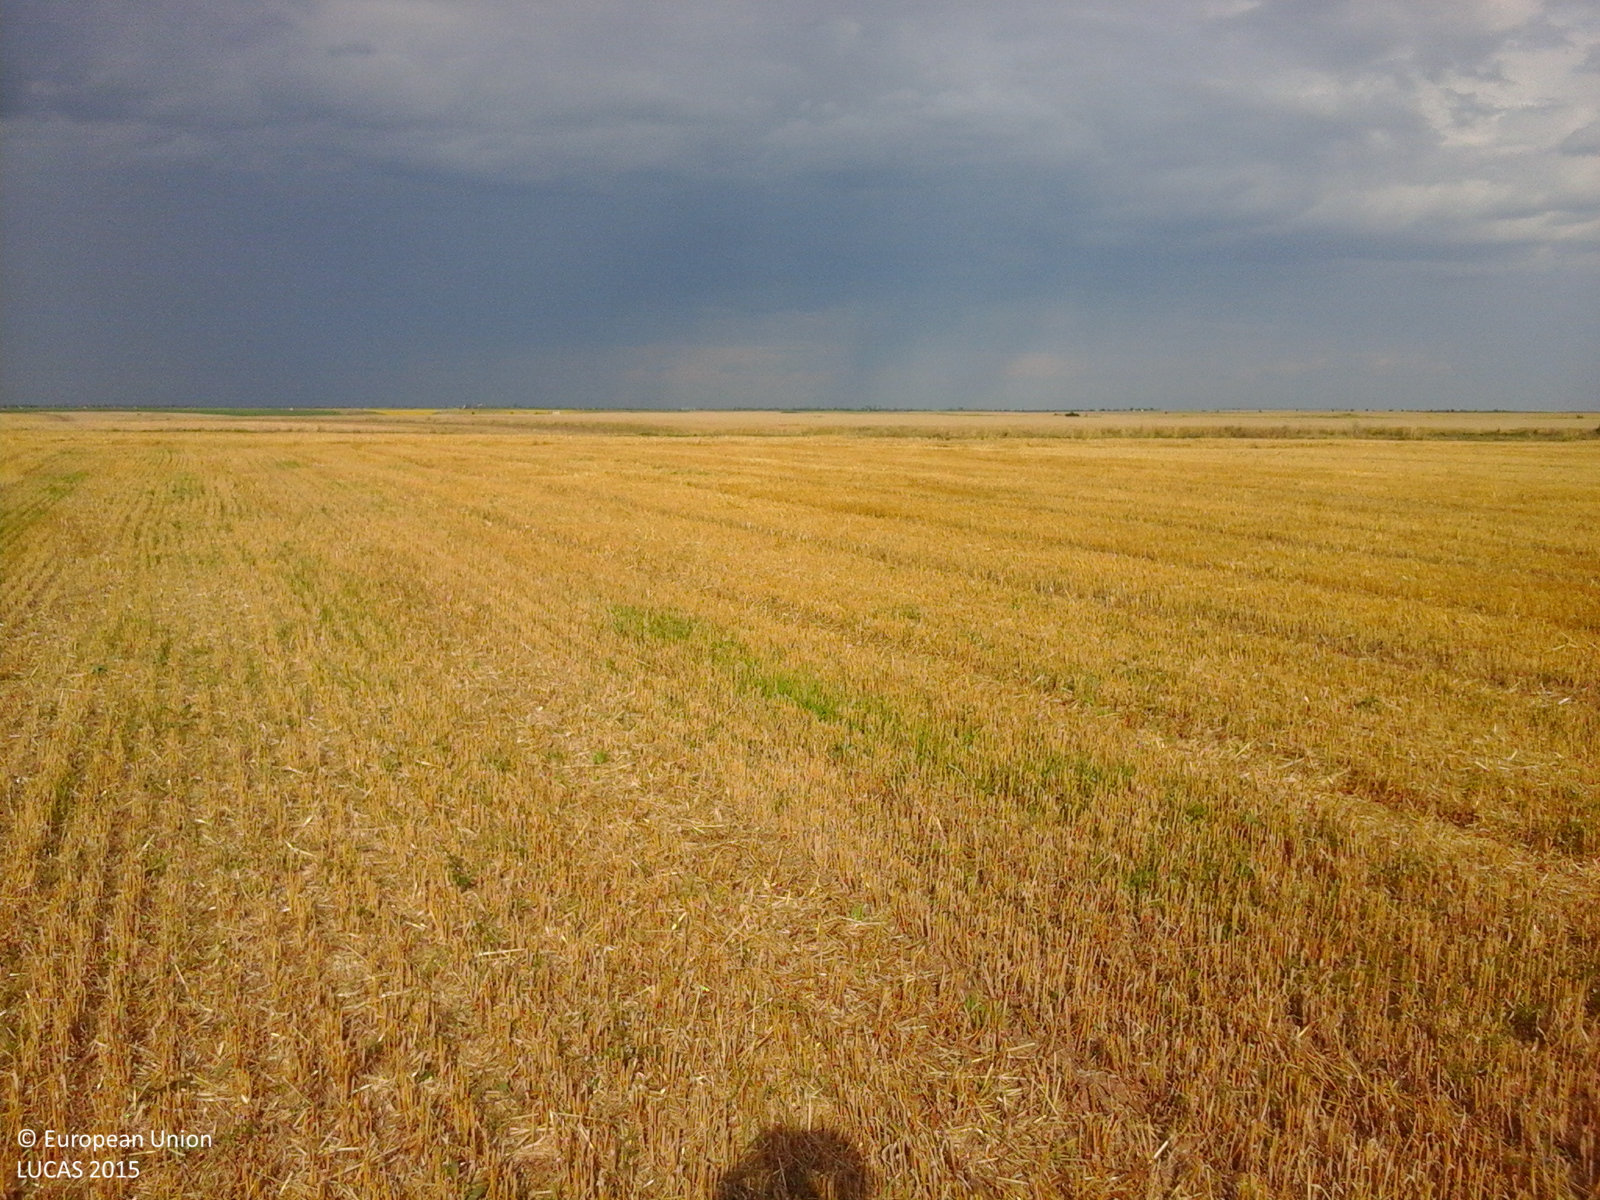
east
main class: Cropland
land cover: Barley
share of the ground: < 10 %
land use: Agriculture (excluding fallow land and kitchen gardens)
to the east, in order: Barley; Grass margins; Tracks; Grass margins; Other bare soil; Tracks; Grass margins; Common wheat
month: July
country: RO
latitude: 44.0954
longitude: 24.6216
